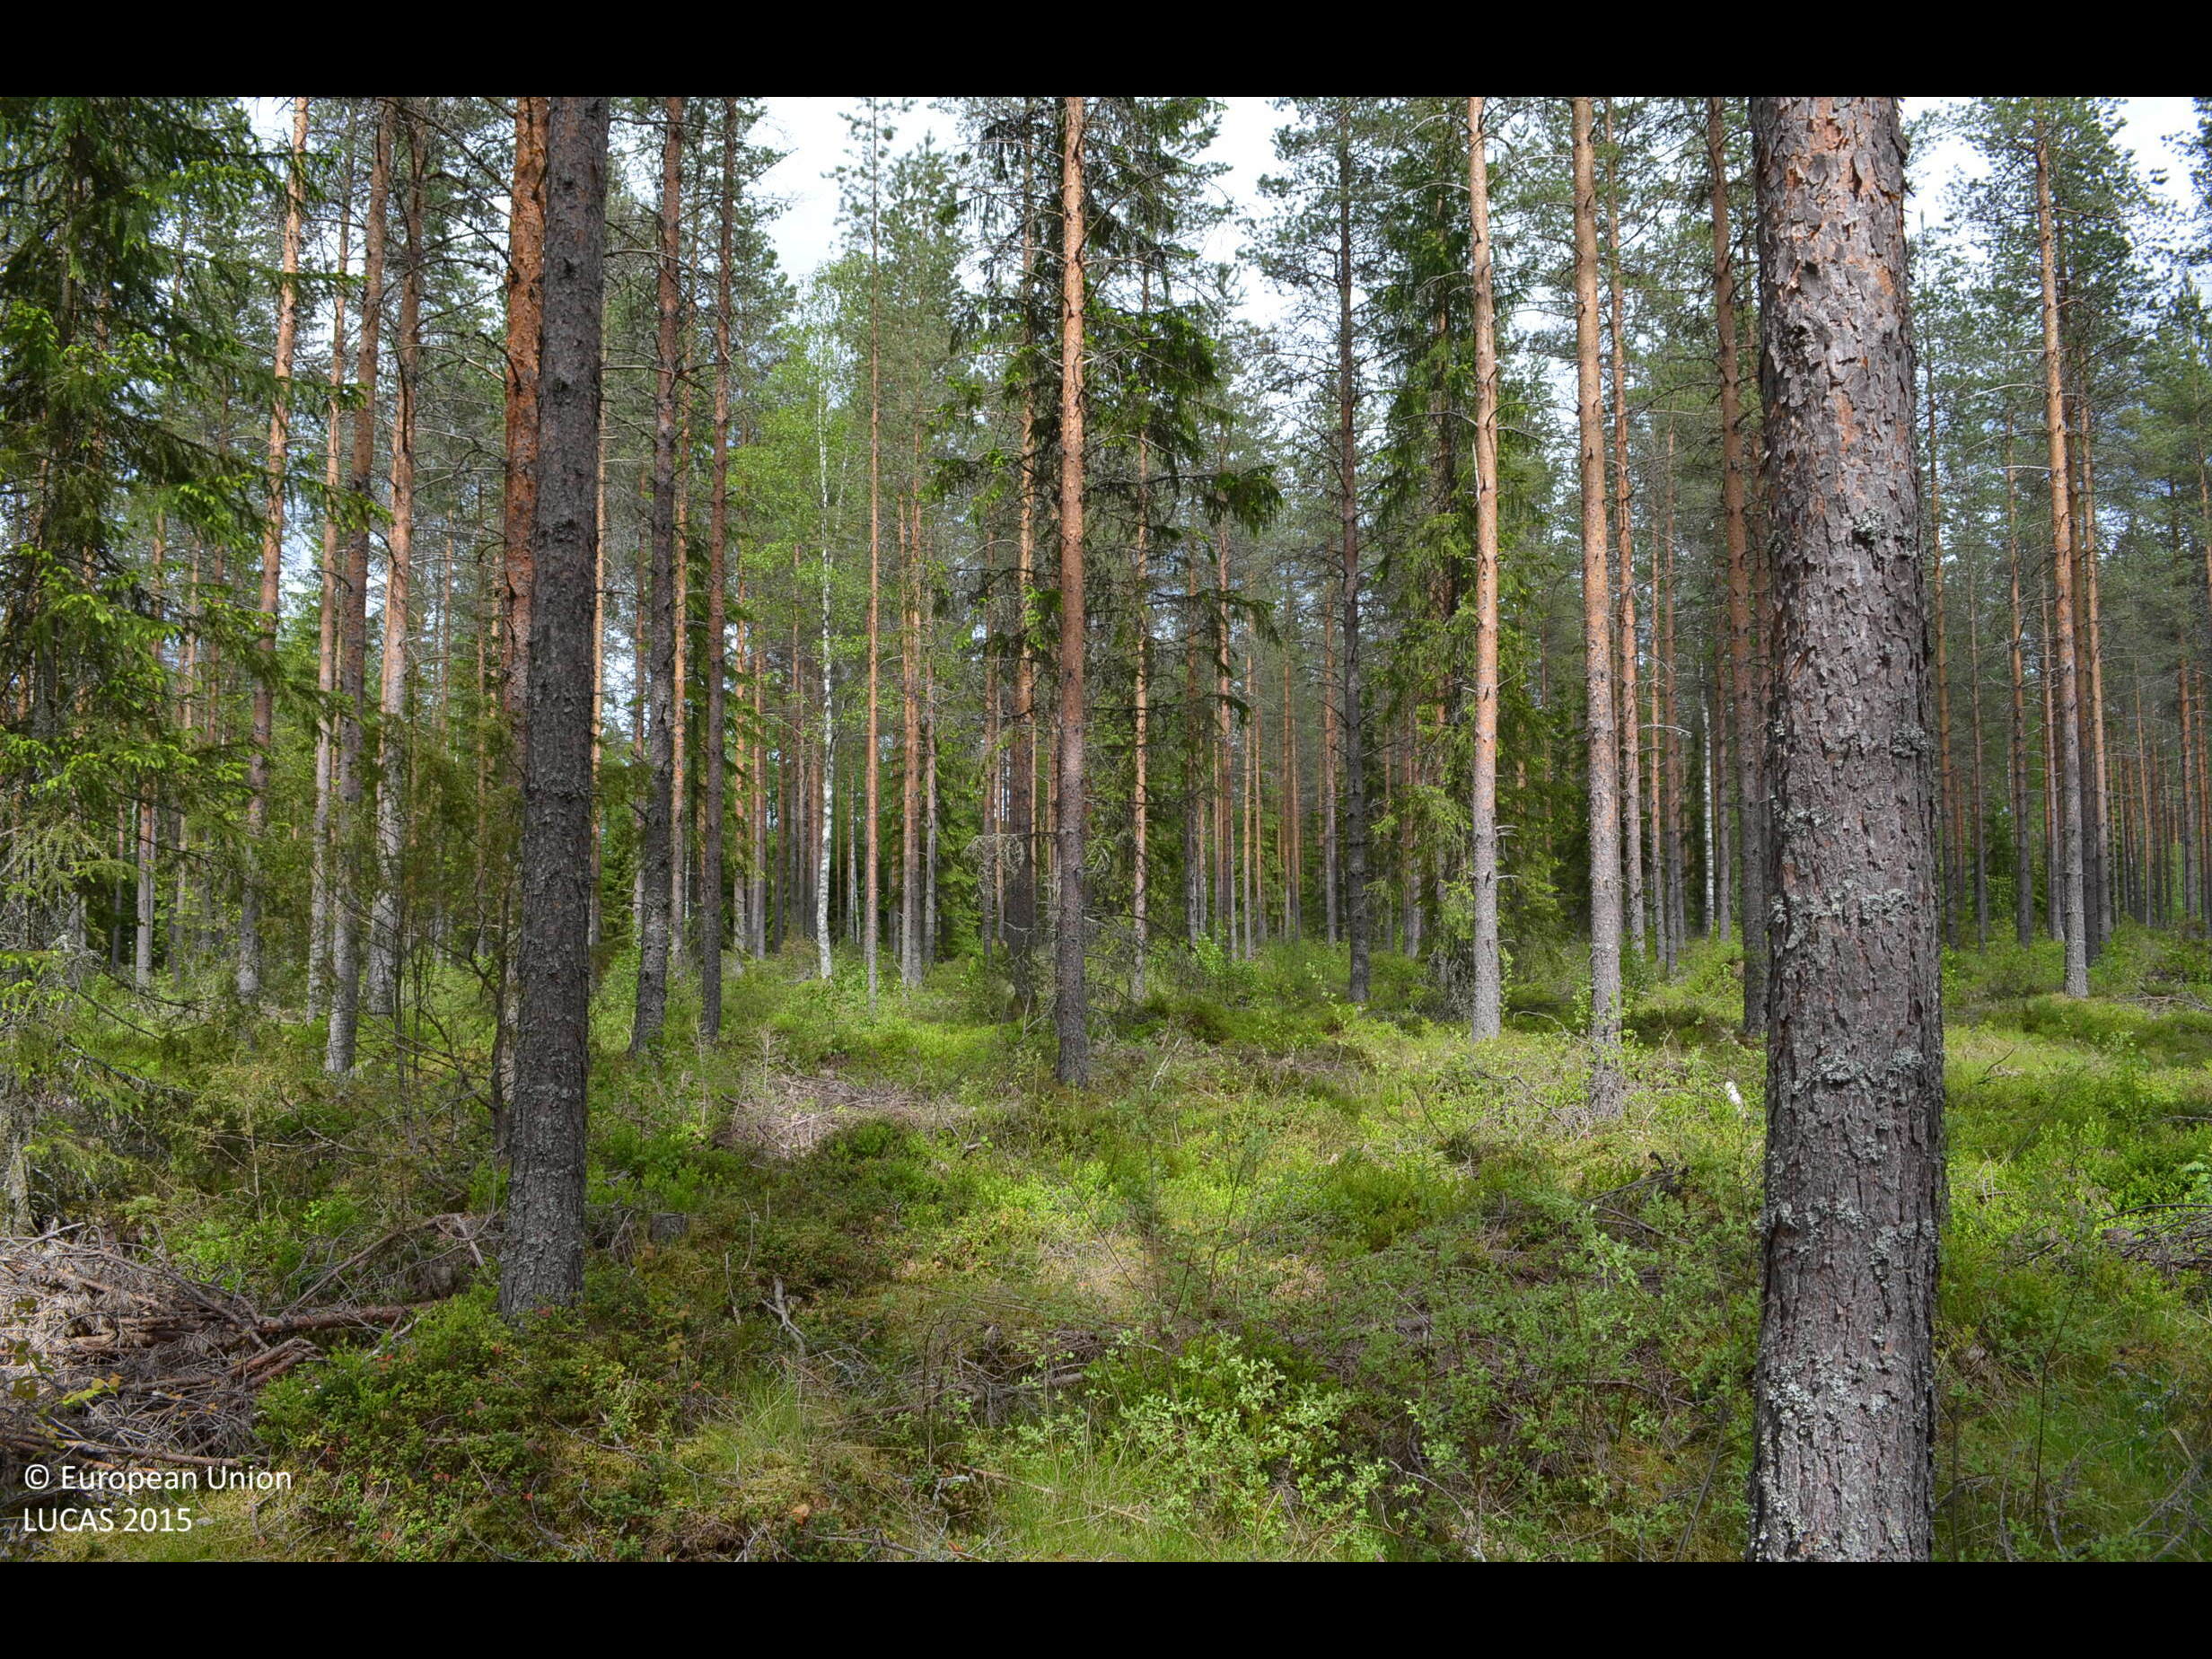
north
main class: Woodland
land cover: Pine dominated coniferous woodland
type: boreal forest
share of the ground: 50 - 75 %
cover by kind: coniferous forest trees 65 %, shrubs 25 %, broadleaved forest trees 5 %
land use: Forestry
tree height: > 5 m
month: June
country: FI
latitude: 61.9927
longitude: 23.1844
